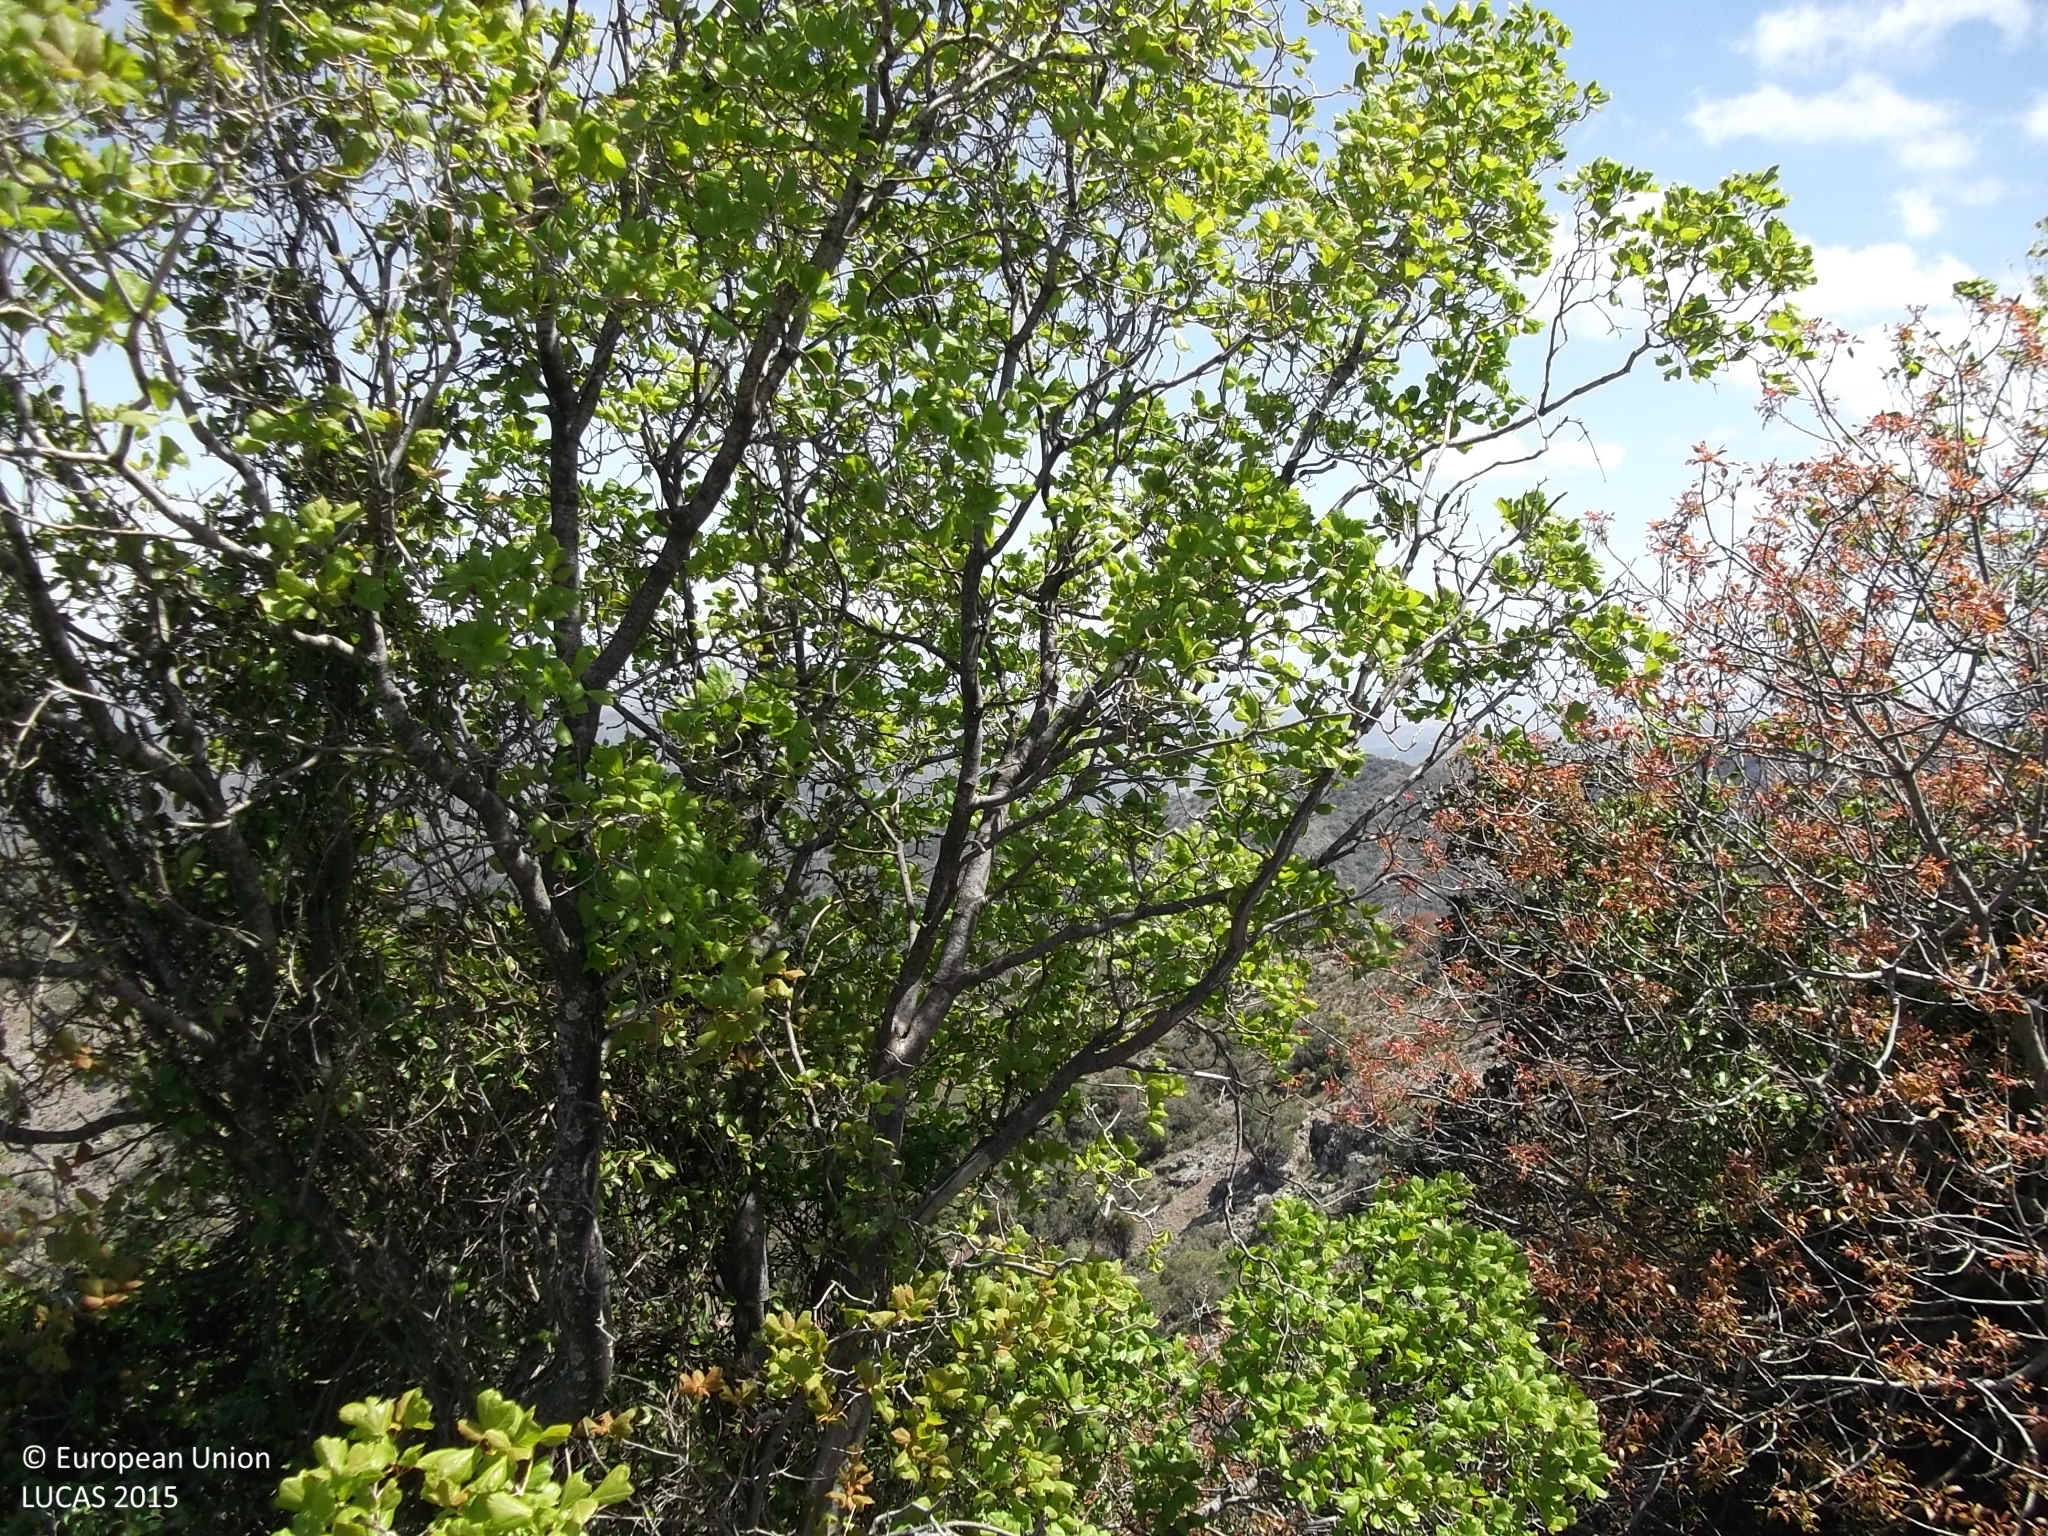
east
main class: Woodland
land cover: Pine dominated mixed woodland
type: coniferous forest of the mediterranean region
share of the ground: > 75 %
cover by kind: coniferous forest trees 60 %, broadleaved forest trees 20 %, unconsolidated bare surface 20 %
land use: Semi-natural and natural areas not in use
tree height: > 5 m
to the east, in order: Pine dominated mixed woodland
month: April
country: CY
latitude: 34.9297
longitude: 33.2019
